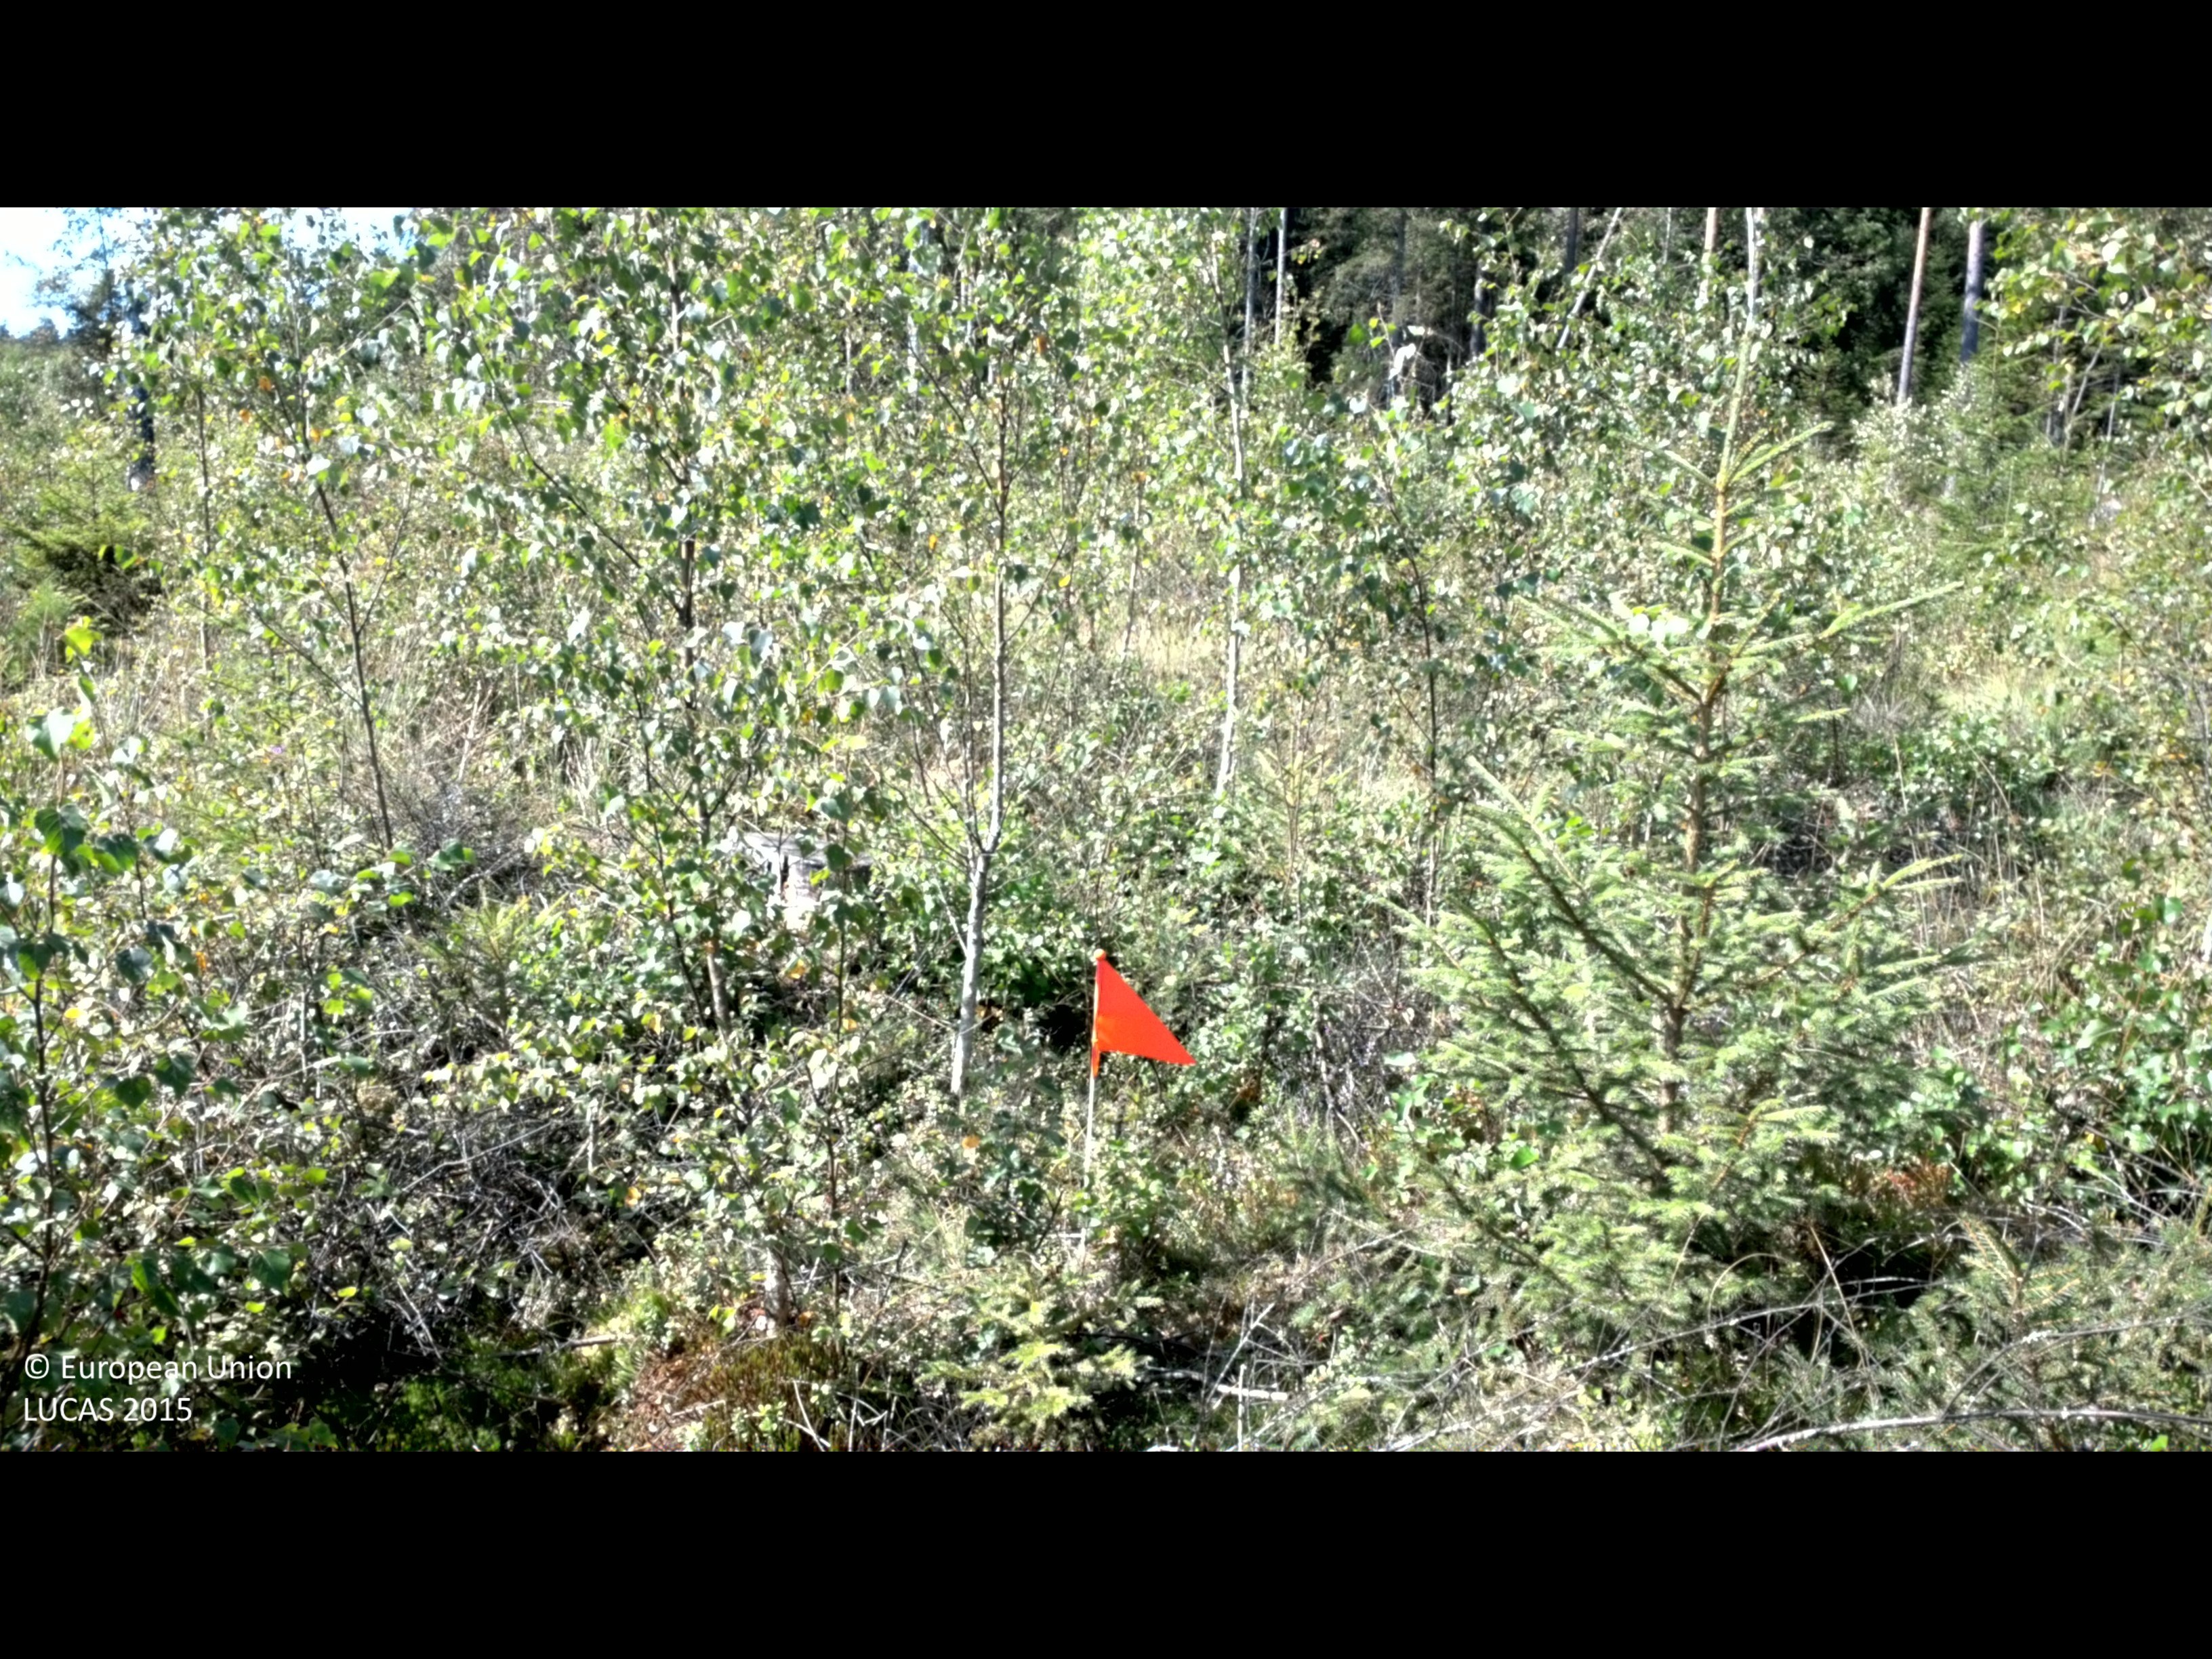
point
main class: Woodland
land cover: Broadleaved woodland
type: boreal forest
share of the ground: 50 - 75 %
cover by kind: broadleaved forest trees 55 %, shrubs 20 %, herbaceous plants 15 %, coniferous forest trees 10 %
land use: Forestry
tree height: < 5 m
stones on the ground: 10 - 25 %
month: August
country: SE
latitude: 56.9776
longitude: 13.7969
